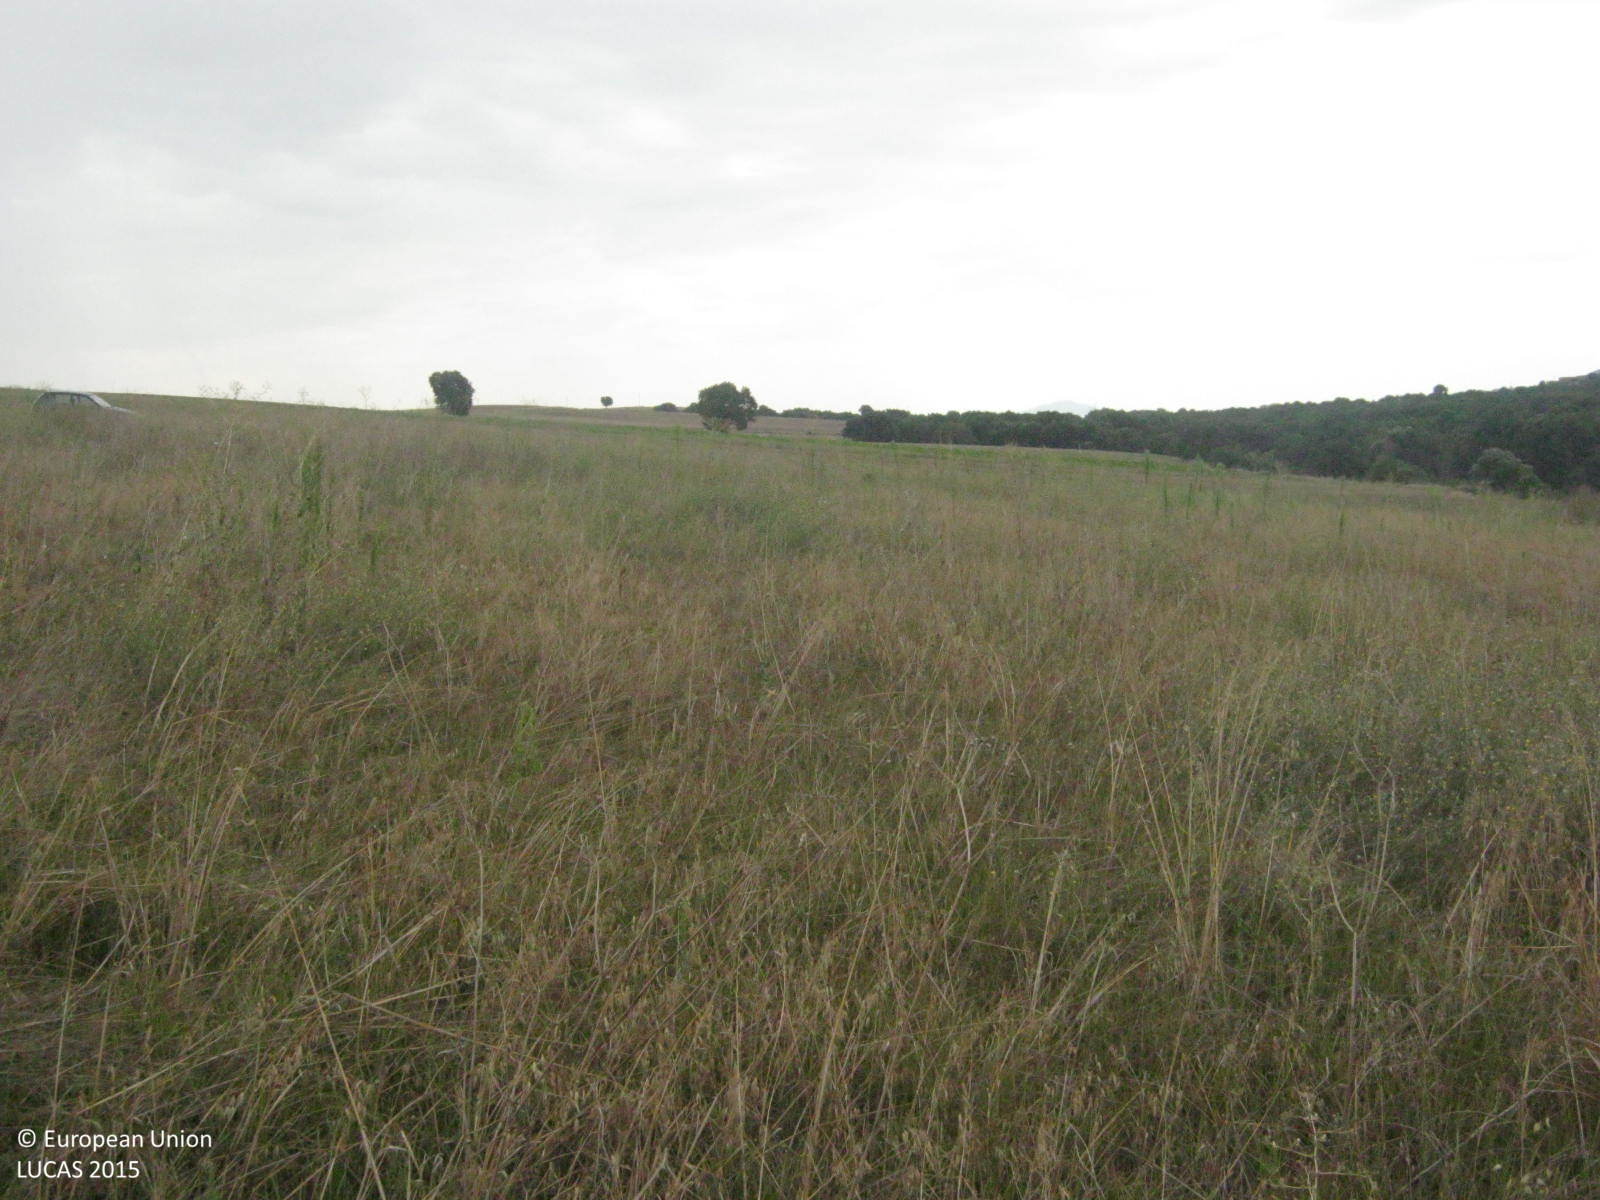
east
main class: Grassland
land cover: Spontaneously vegetated surfaces
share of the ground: > 75 %
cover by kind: herbaceous plants 100 %
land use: Agriculture (excluding fallow land and kitchen gardens)
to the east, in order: Spontaneously vegetated surfaces; Tracks; Common wheat; Tracks; Electric lines; Broadleaved woodland
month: August
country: GR
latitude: 40.8857
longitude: 22.9582
